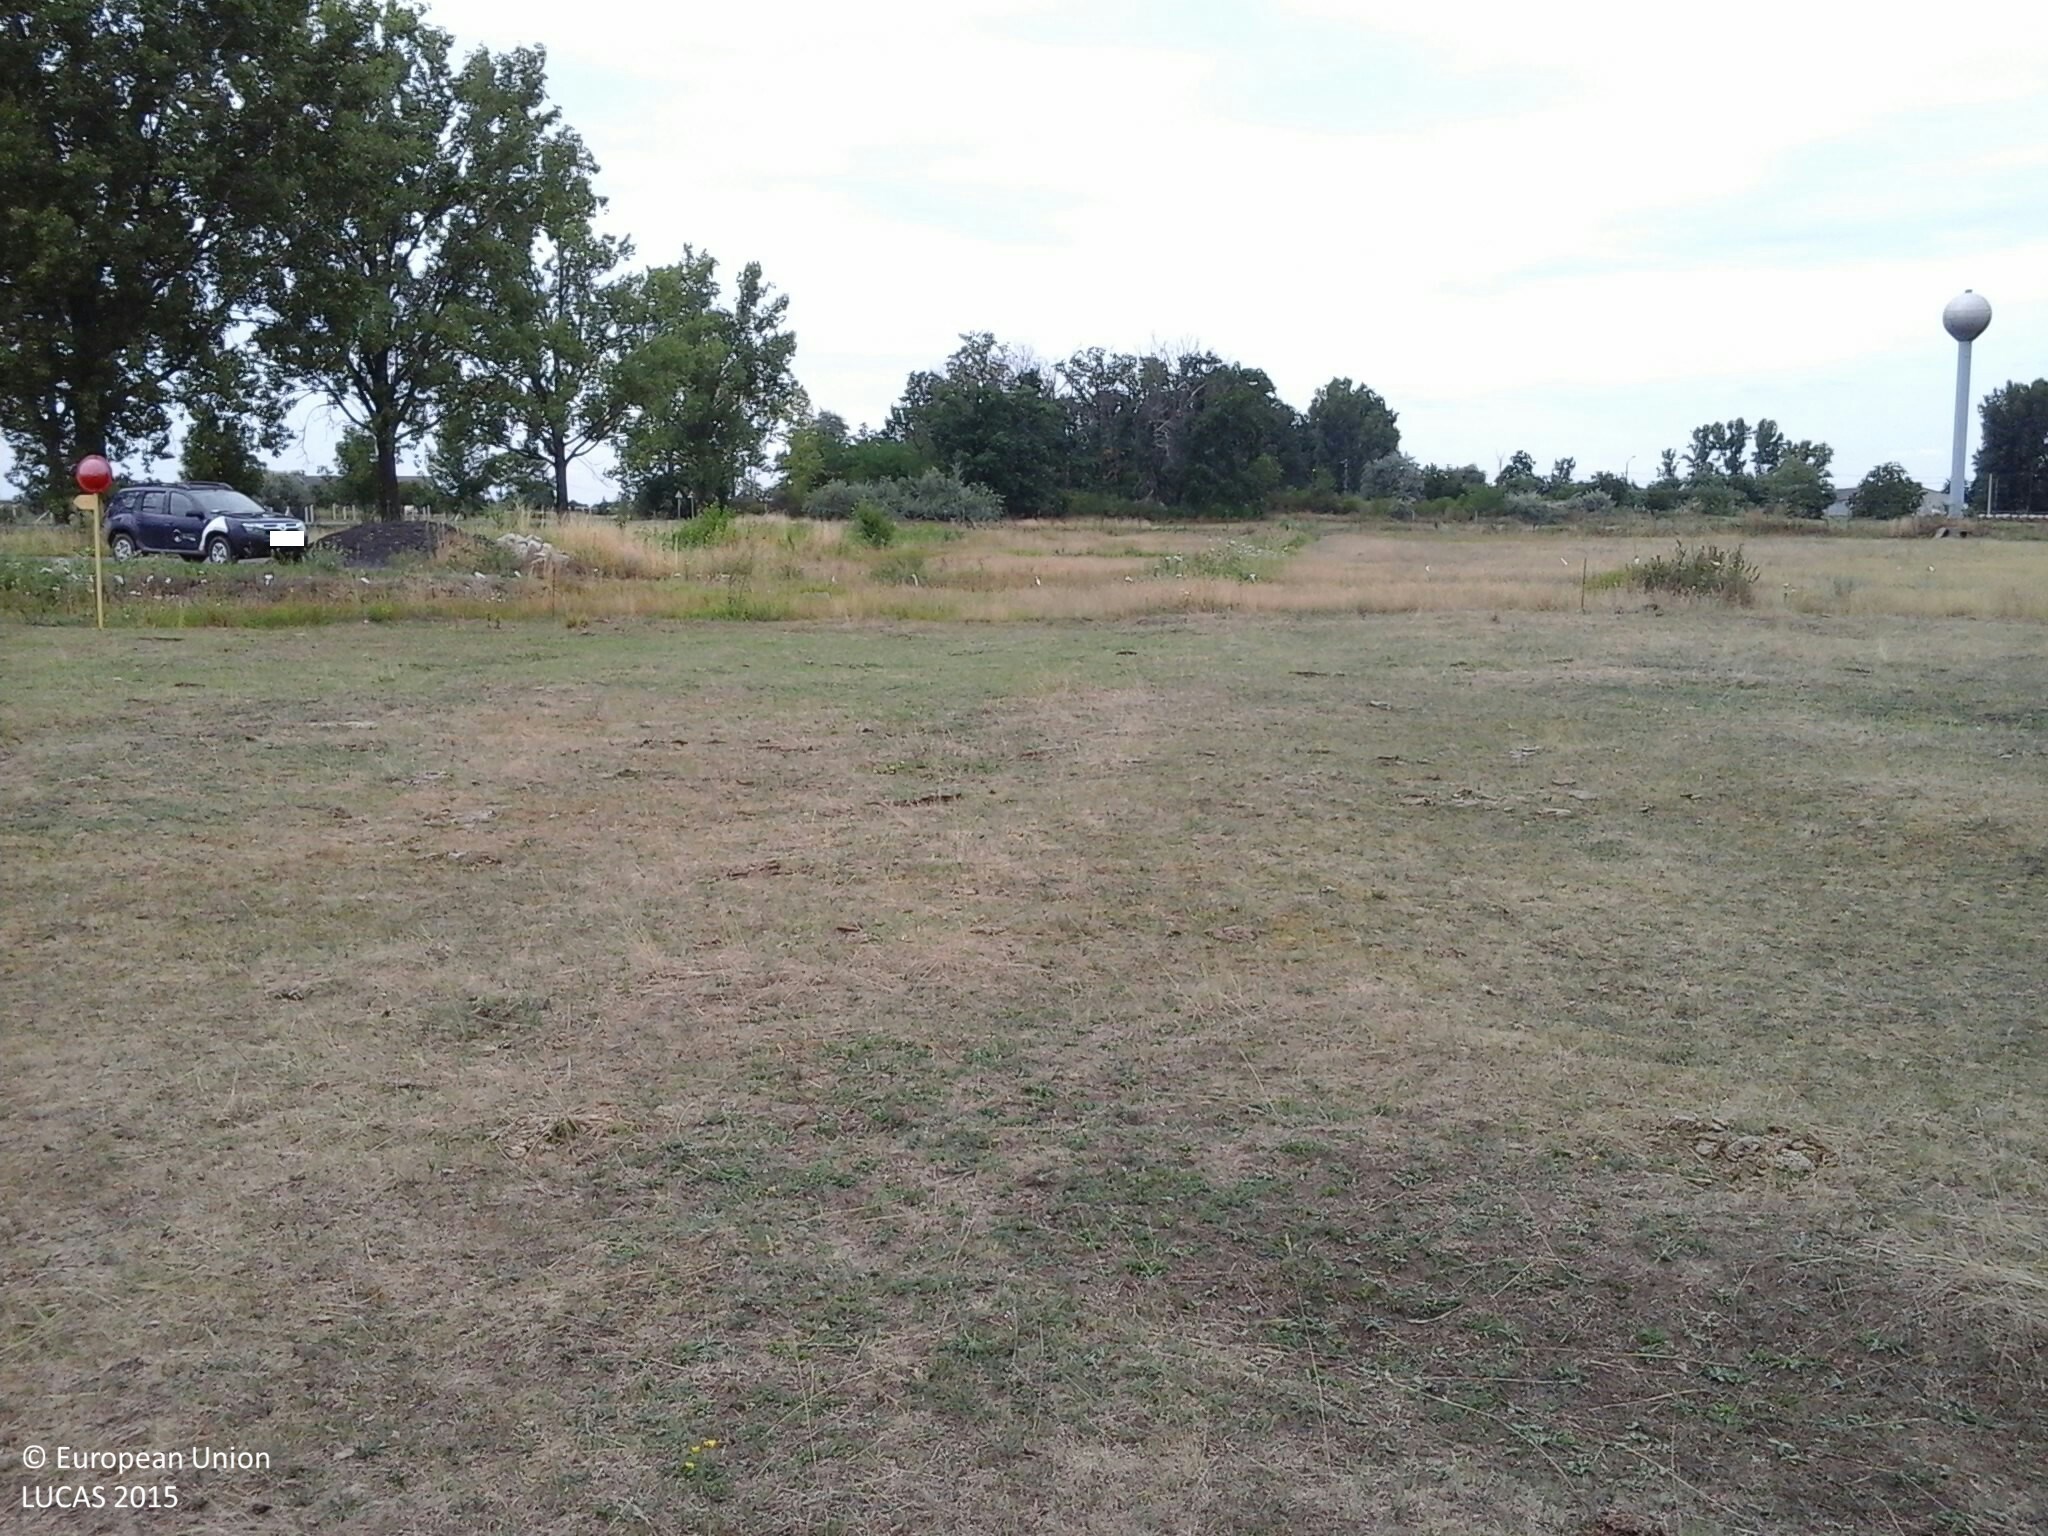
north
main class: Grassland
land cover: Grassland without tree/shrub cover
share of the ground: > 75 %
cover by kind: herbaceous plants 100 %
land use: Agriculture (excluding fallow land and kitchen gardens)
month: July
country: HU
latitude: 47.8642
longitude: 21.4194
